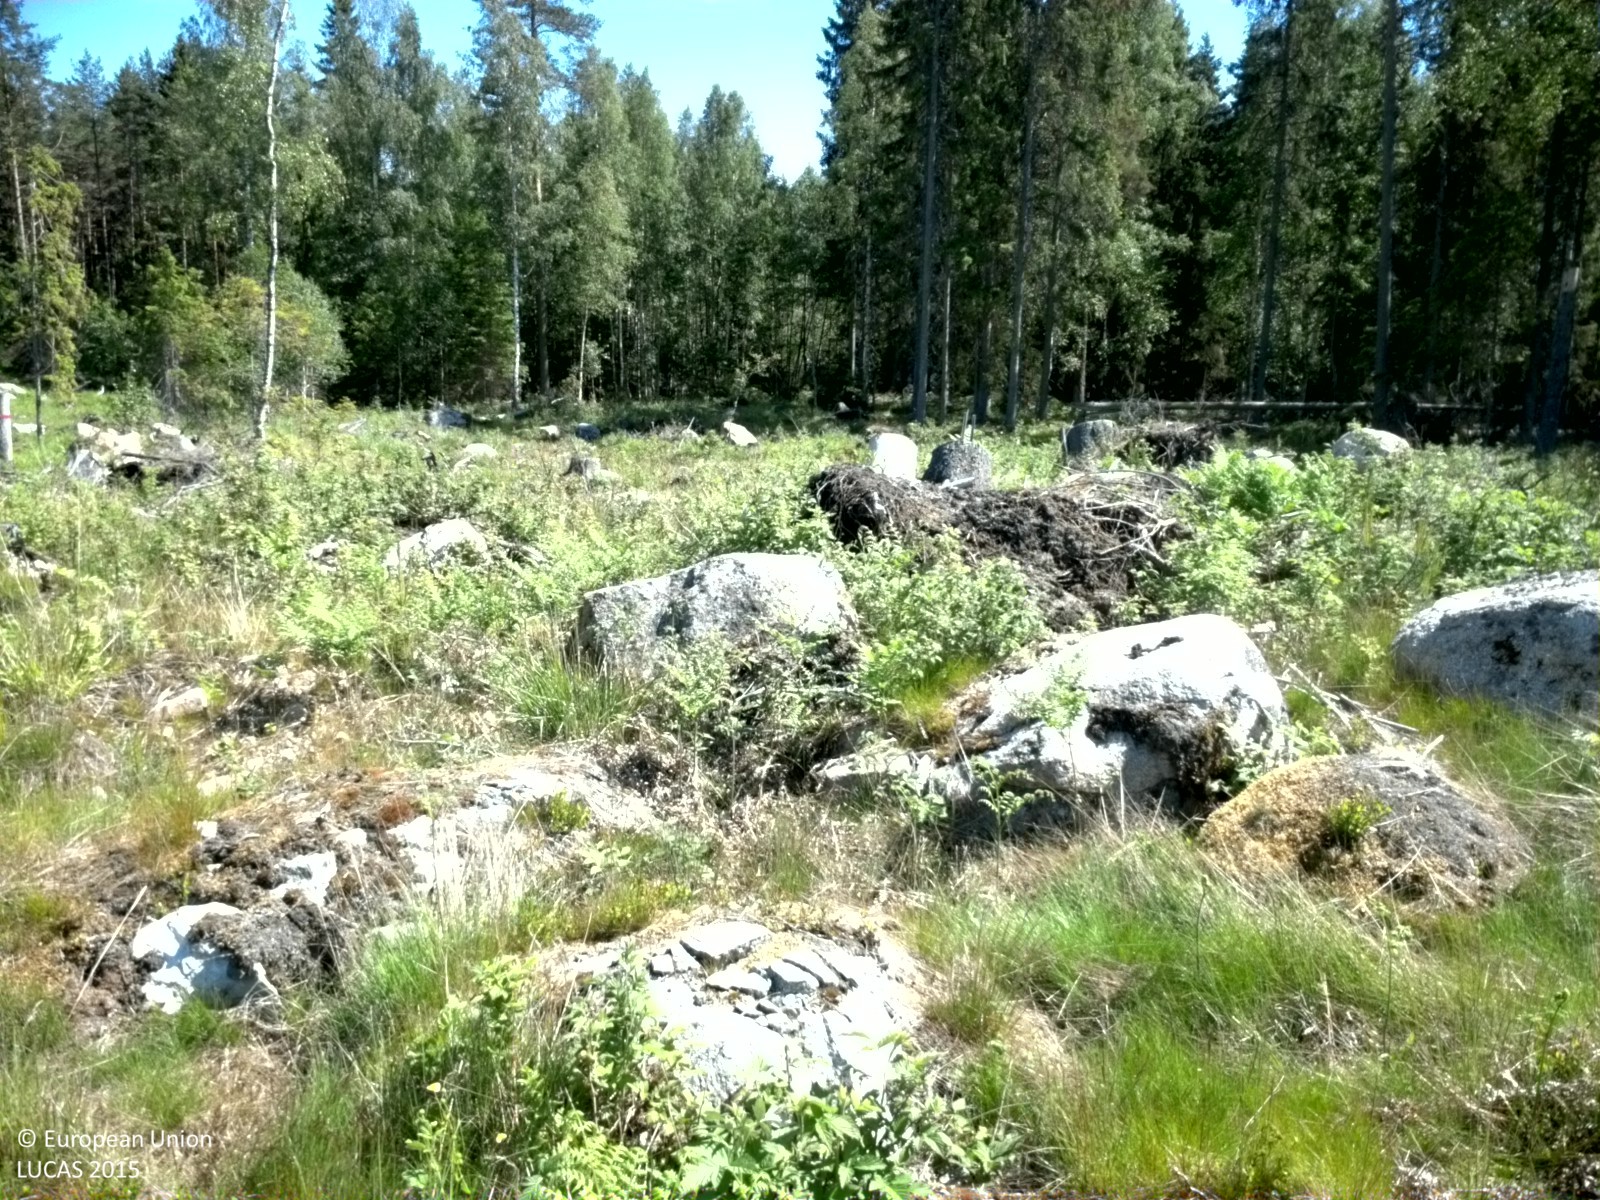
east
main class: Grassland
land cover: Grassland with sparse tree/shrub cover
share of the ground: > 75 %
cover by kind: herbaceous plants 65 %, shrubs 10 %, consolidated bare surface 10 %, broadleaved forest trees 5 %
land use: Forestry
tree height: > 5 m
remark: Clear cut
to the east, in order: Grassland with sparse tree/shrub cover; Broadleaved woodland; Spruce dominated mixed woodland; Fences; Spruce dominated mixed woodland; Other coniferous woodland
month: June
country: SE
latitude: 60.2472
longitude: 17.5978
